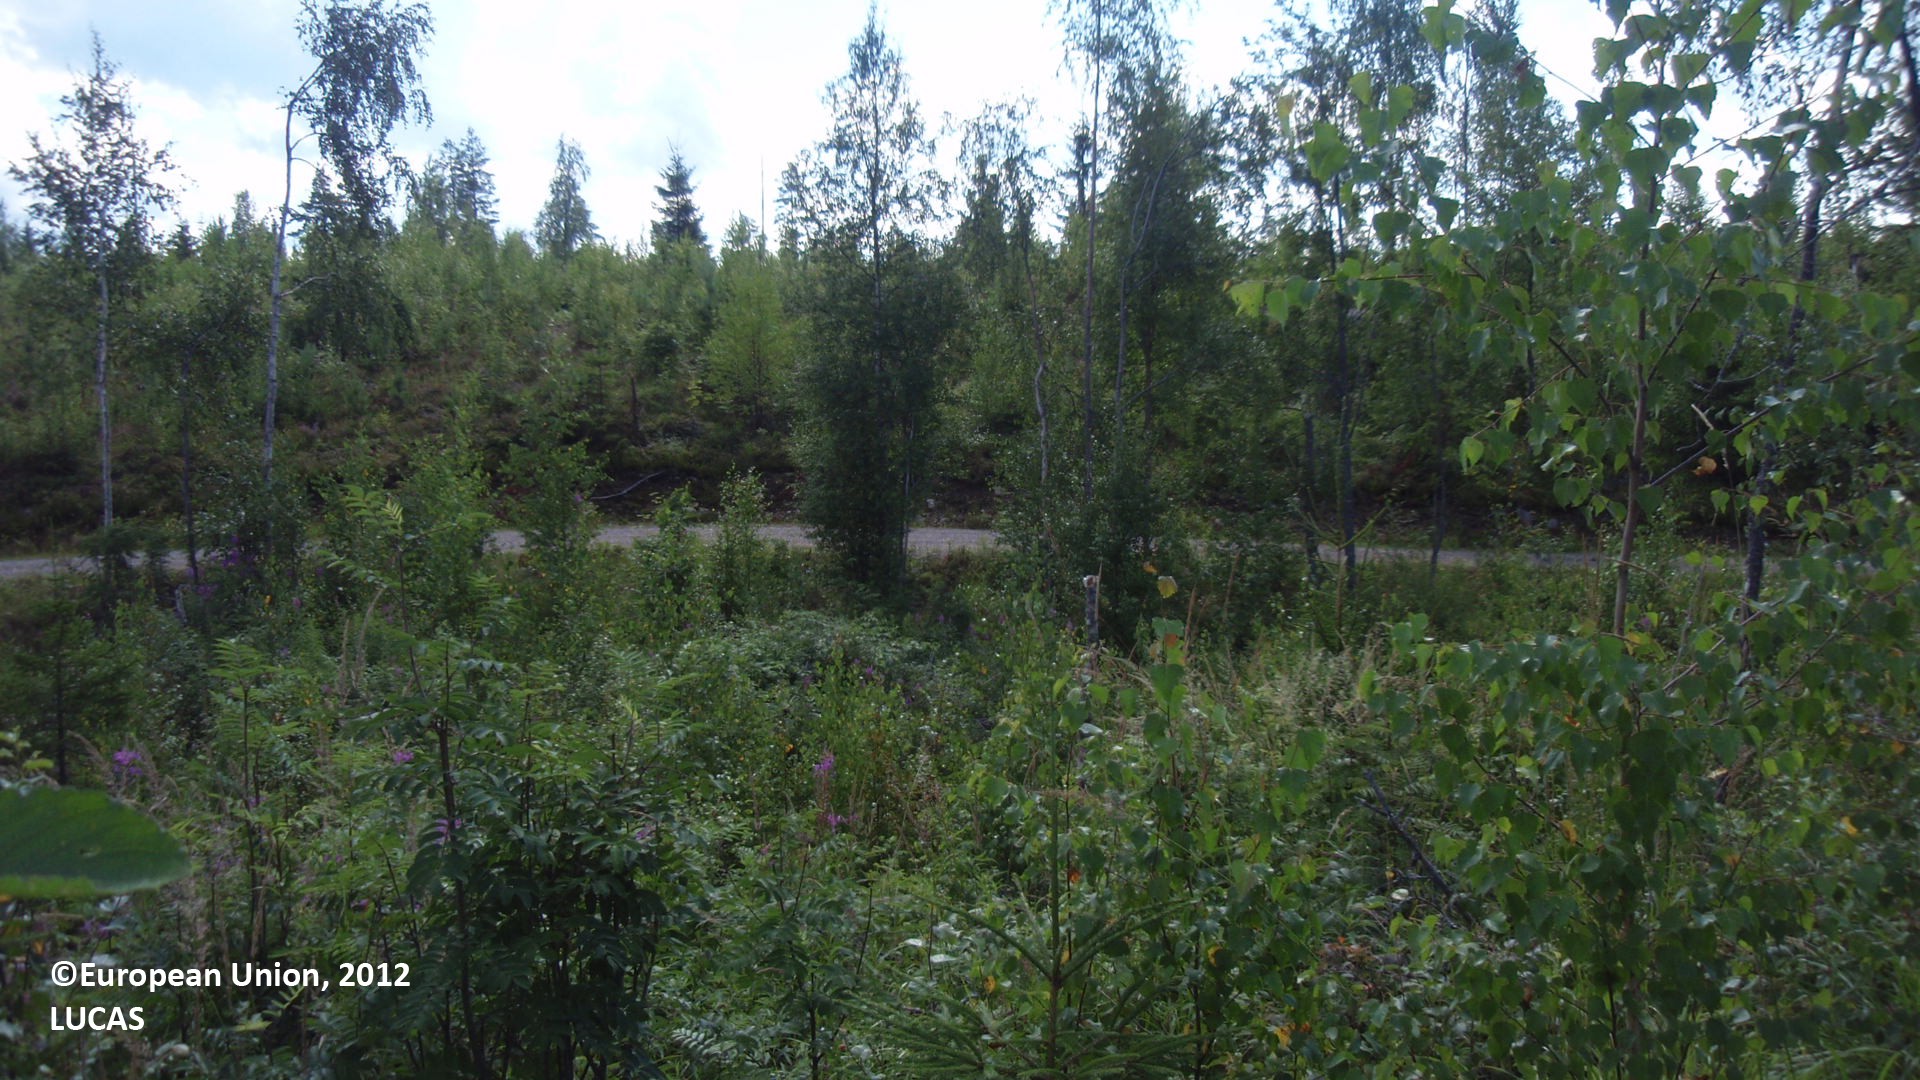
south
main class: Shrubland
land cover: Shrubland with sparse tree cover
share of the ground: > 75 %
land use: Forestry
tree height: < 5 m
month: July
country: FI
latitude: 61.4313
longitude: 28.9174
